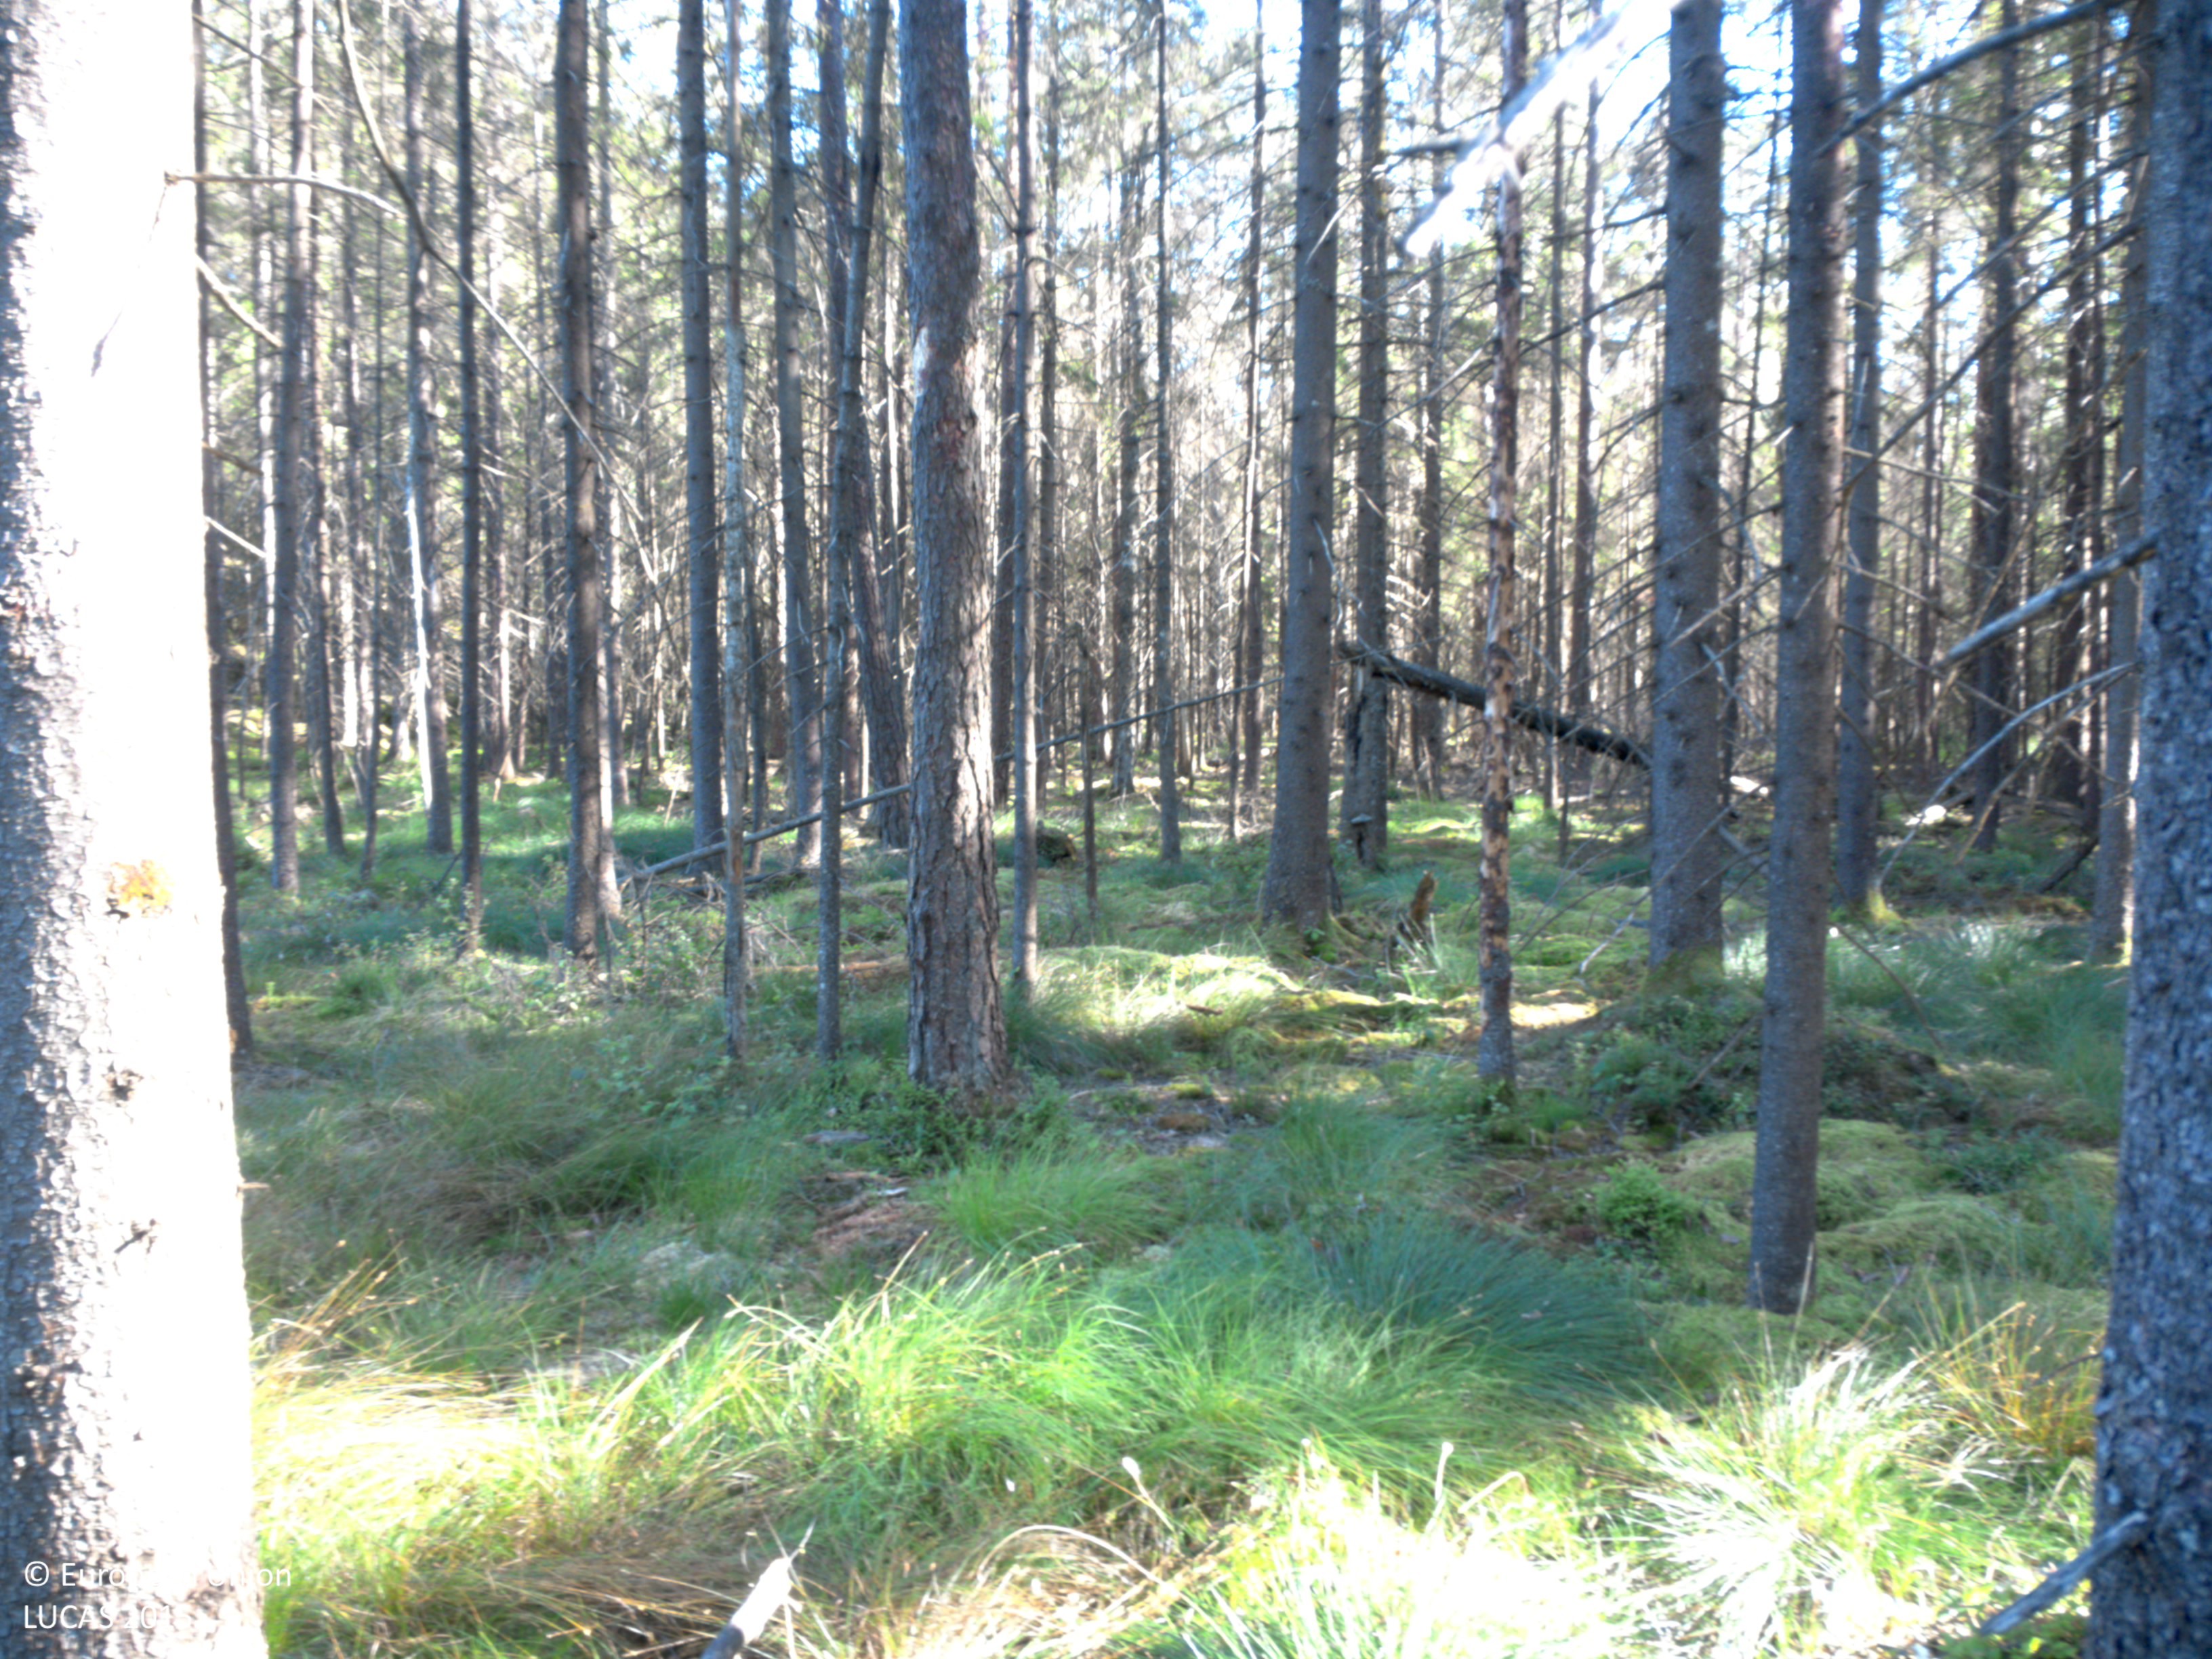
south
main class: Woodland
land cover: Spruce dominated coniferous woodland
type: boreal forest
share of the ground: 50 - 75 %
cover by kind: coniferous forest trees 60 %, lichens and mosses 25 %, herbaceous plants 10 %, broadleaved forest trees 5 %
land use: Forestry
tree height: > 5 m
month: August
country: SE
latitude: 58.5453
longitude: 12.0746
